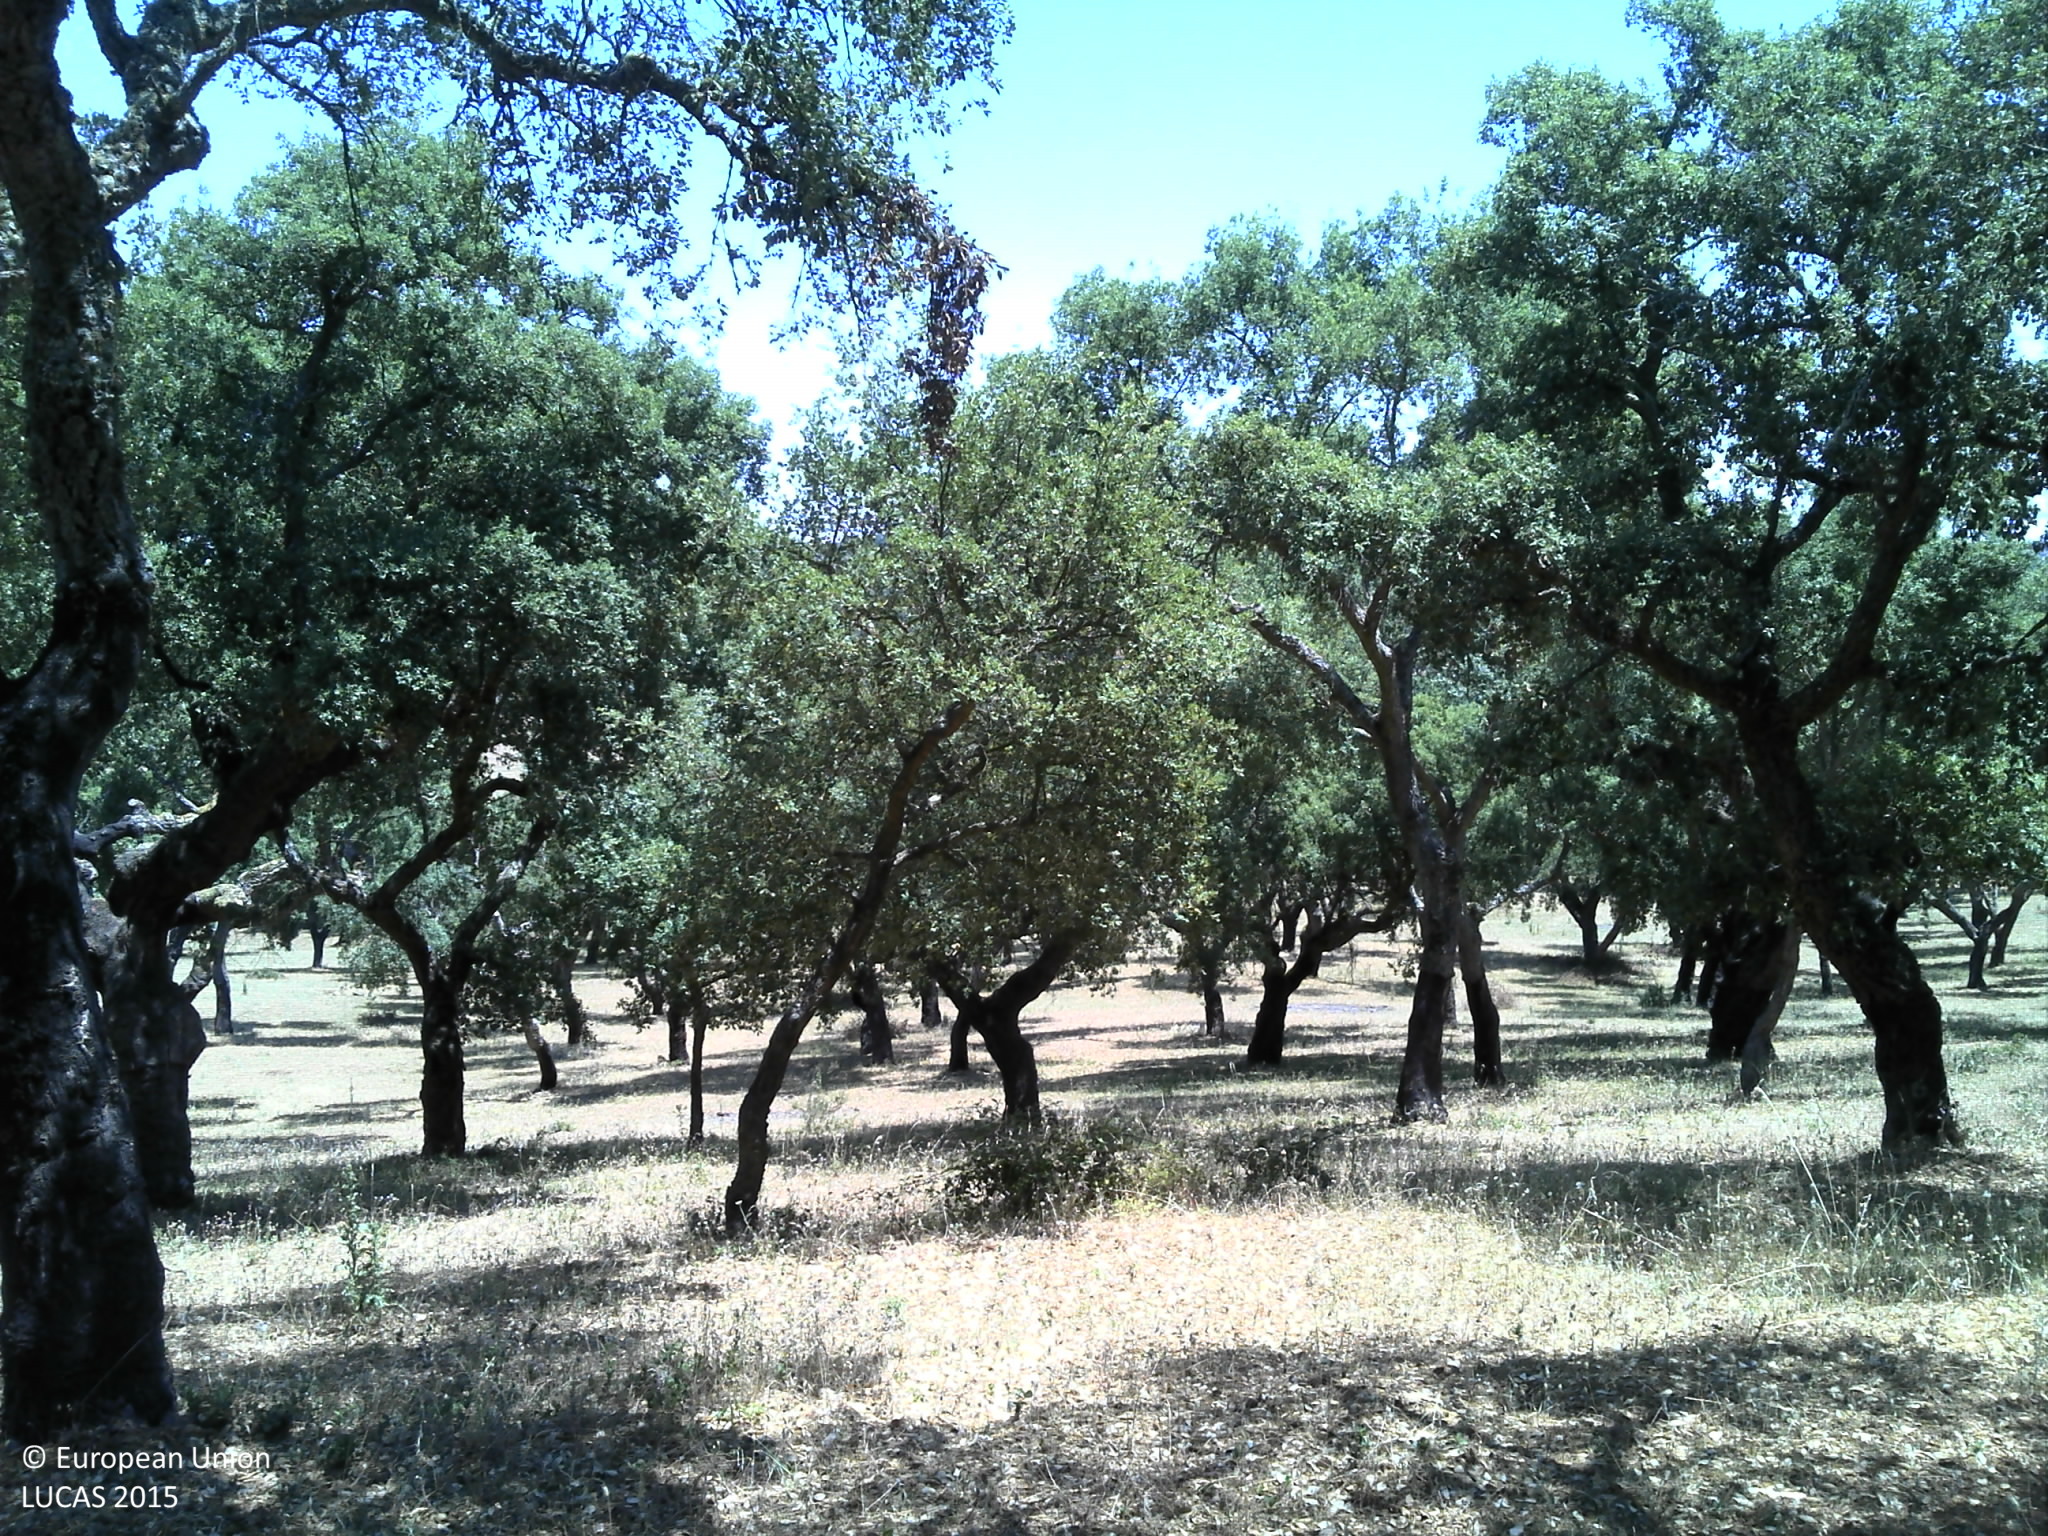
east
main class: Woodland
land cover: Broadleaved woodland
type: broadleaved evergreen forest
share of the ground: 50 - 75 %
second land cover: Grassland without tree/shrub cover
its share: 10 - 25 %
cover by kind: broadleaved forest trees 75 %, unconsolidated bare surface 15 %, herbaceous plants 10 %
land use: Forestry
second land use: Agriculture (excluding fallow land and kitchen gardens)
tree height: > 5 m
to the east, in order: Broadleaved woodland; Grassland without tree/shrub cover; Broadleaved woodland
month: June
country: PT
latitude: 38.6124
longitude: -8.1571
